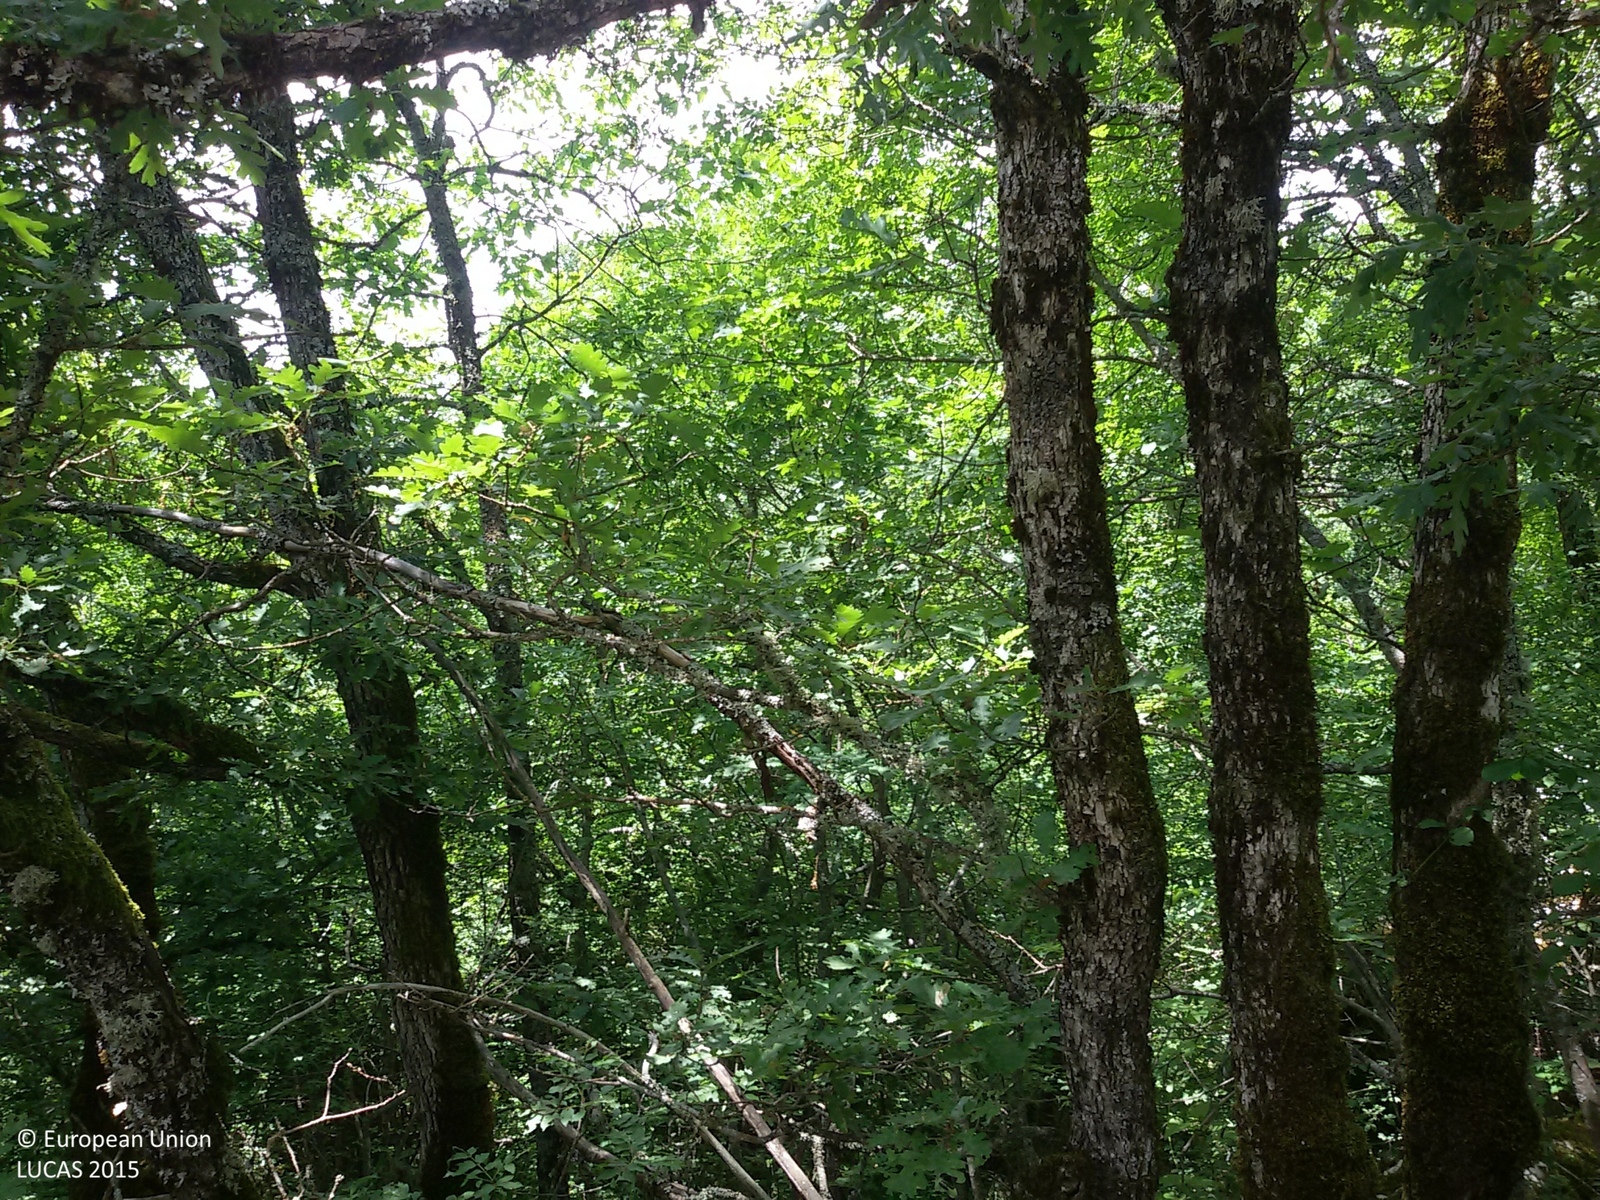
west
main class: Woodland
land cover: Broadleaved woodland
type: acidophilous oak and oak-birch forest
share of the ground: 50 - 75 %
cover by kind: broadleaved forest trees 60 %, lichens and mosses 15 %, shrubs 10 %, consolidated bare surface 10 %, unconsolidated bare surface 5 %
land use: Semi-natural and natural areas not in use
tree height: > 5 m
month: June
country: HR
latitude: 44.5471
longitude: 15.5192
